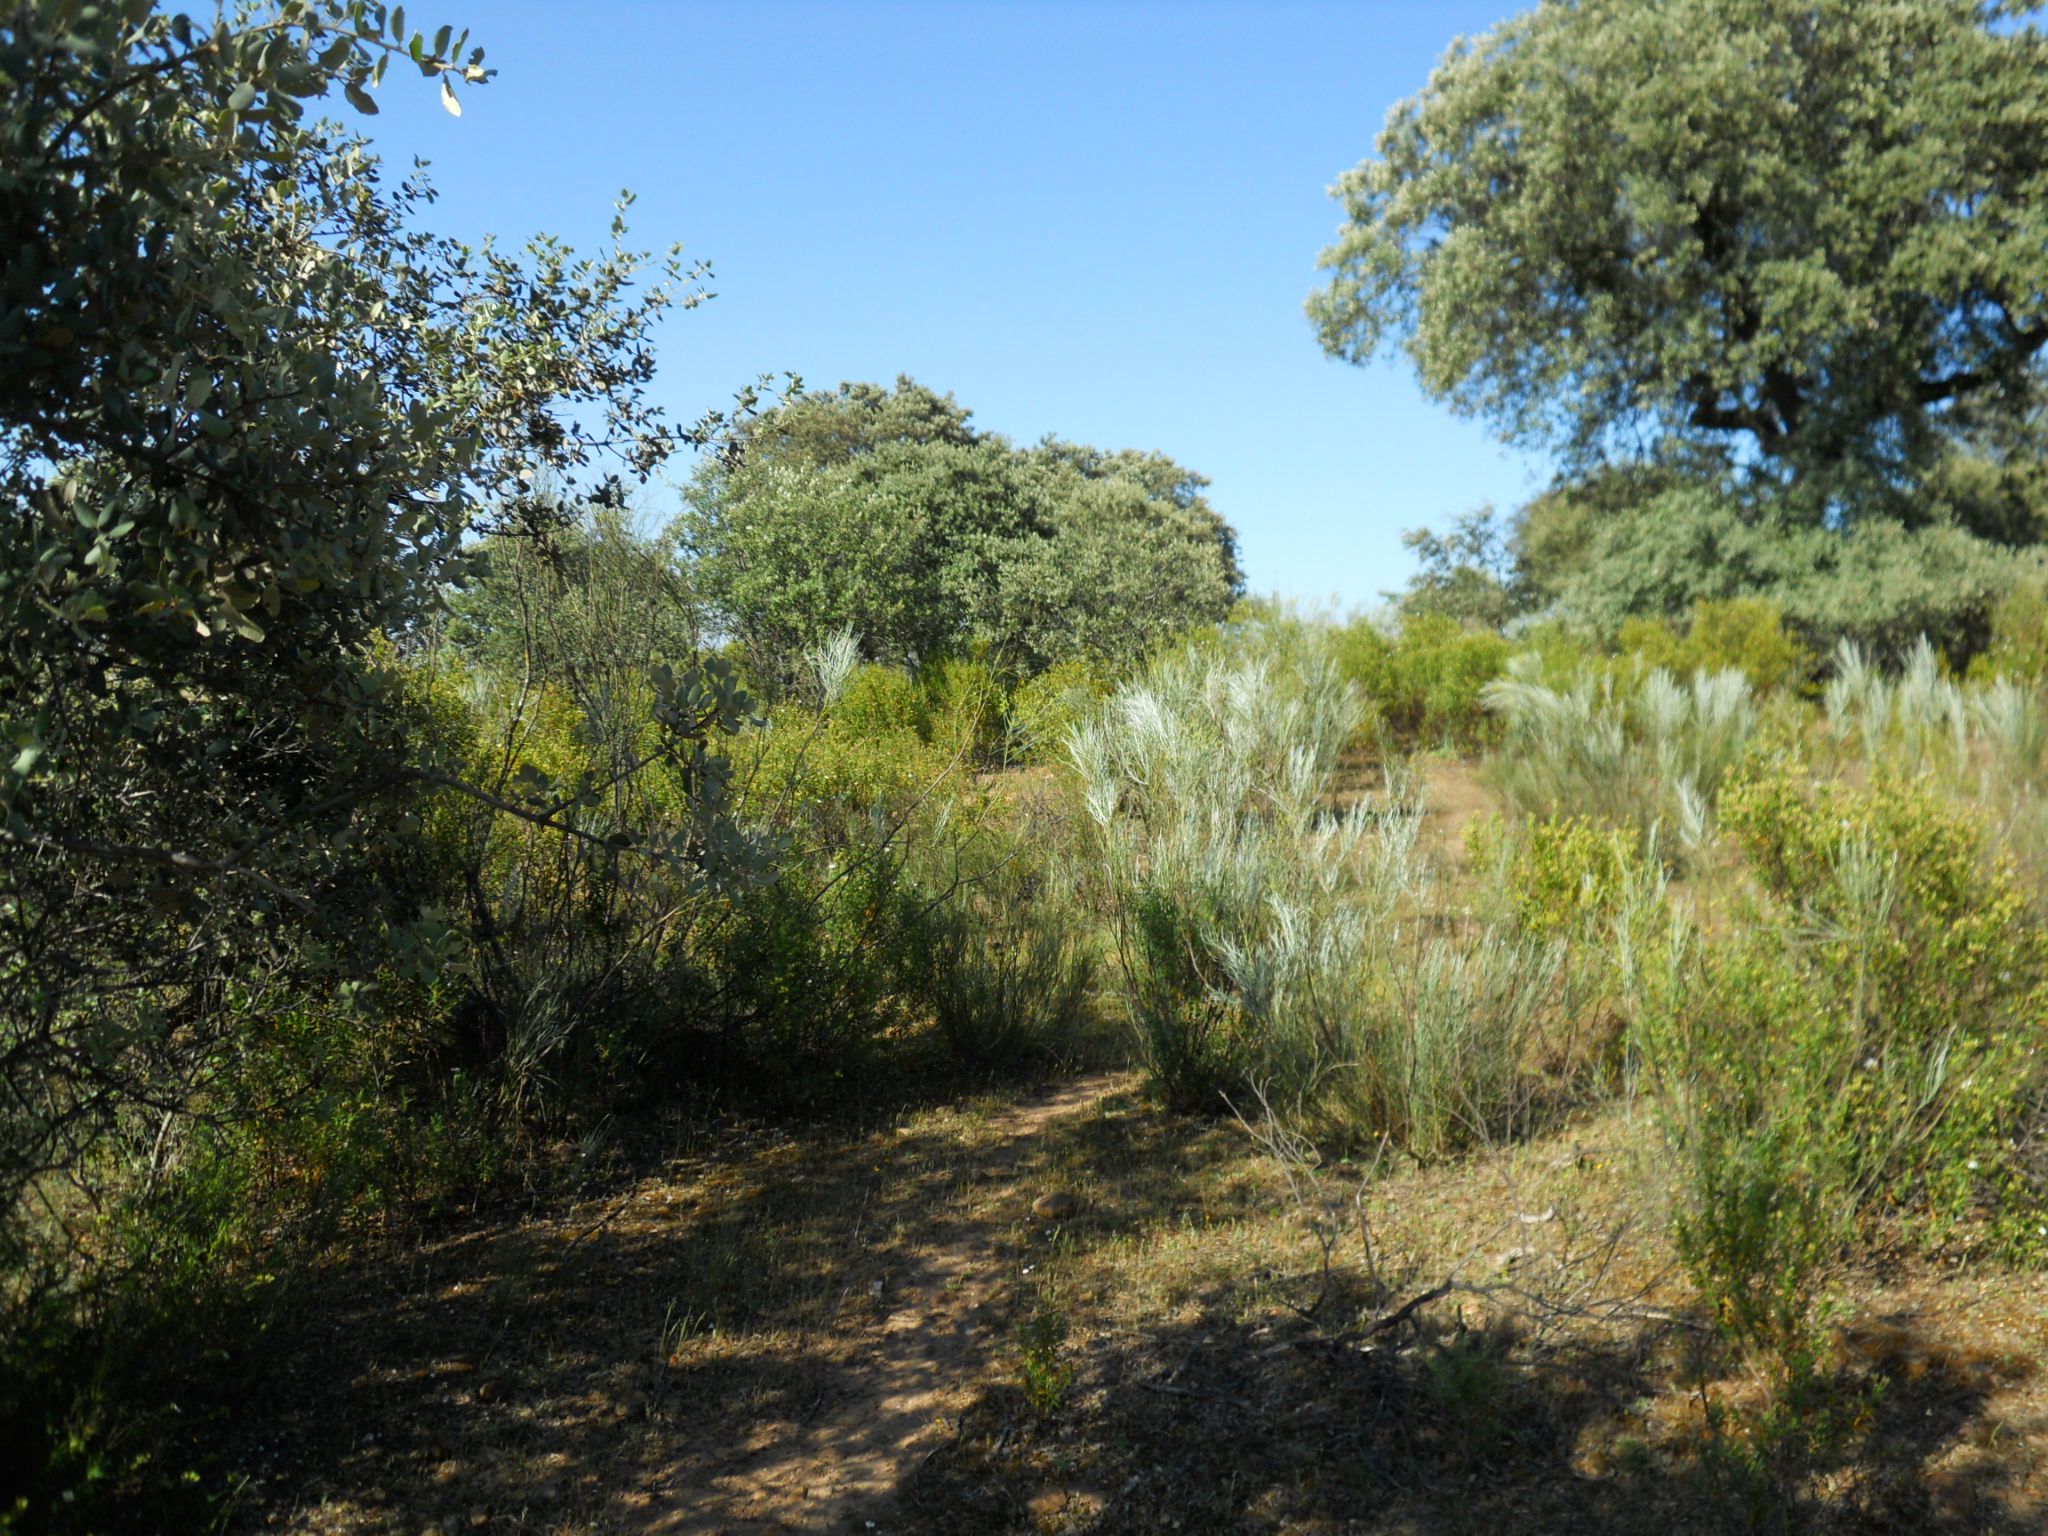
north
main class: Woodland
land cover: Broadleaved woodland
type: broadleaved evergreen forest
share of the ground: > 75 %
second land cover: Shrubland without tree cover
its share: > 75 %
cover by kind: broadleaved forest trees 80 %, shrubs 15 %, herbaceous plants 5 %
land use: Forestry
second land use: Agriculture (excluding fallow land and kitchen gardens)
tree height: > 5 m
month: May
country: ES
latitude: 39.0391
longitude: -6.5266
